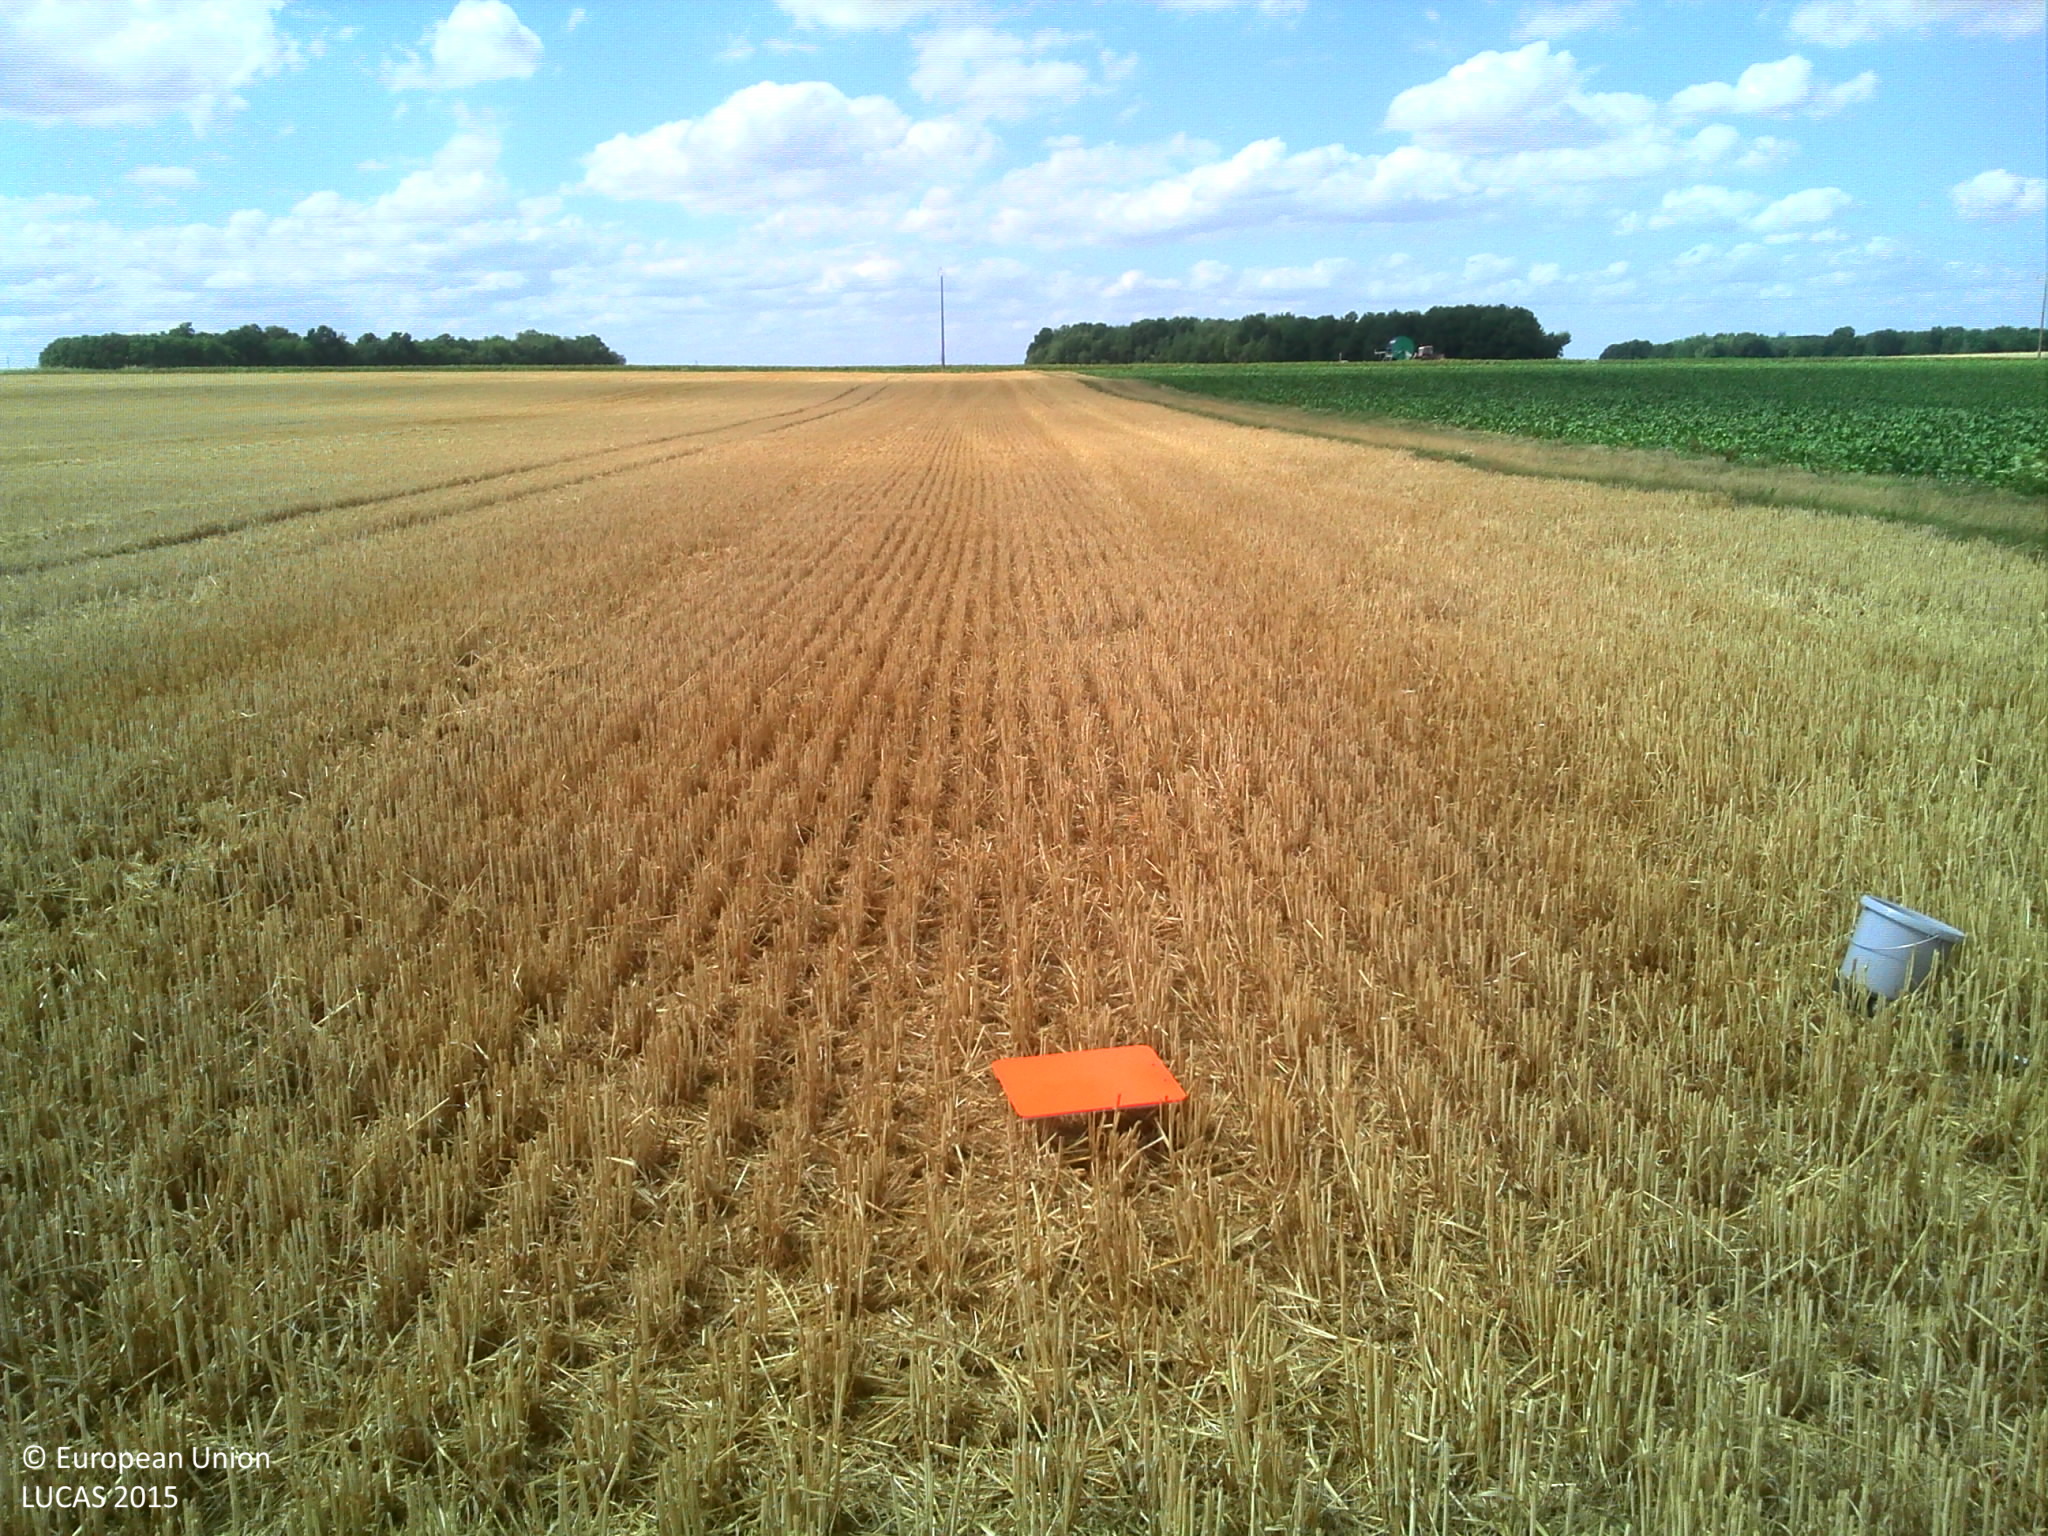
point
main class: Cropland
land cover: Common wheat
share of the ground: 10 - 25 %
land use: Agriculture (excluding fallow land and kitchen gardens)
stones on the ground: 10 - 25 %
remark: Harvested field
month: August
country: FR
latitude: 48.6190
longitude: 3.3597
